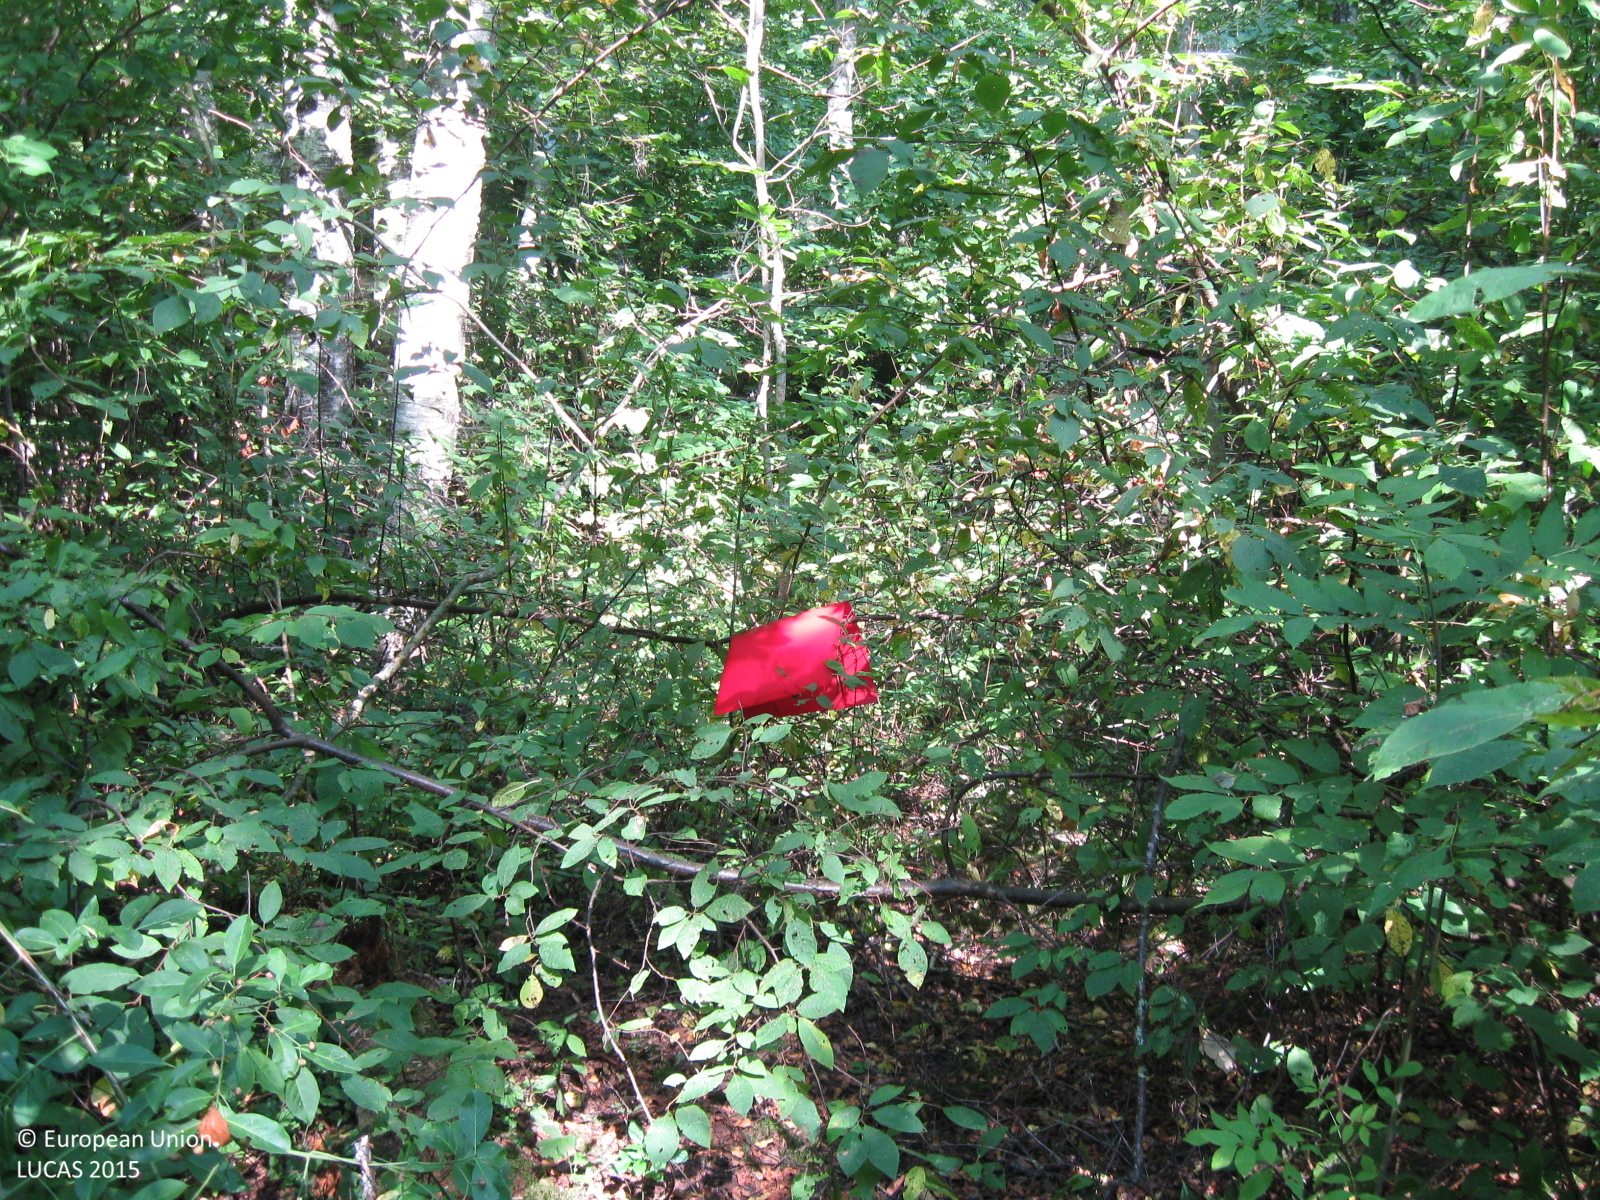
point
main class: Woodland
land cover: Broadleaved woodland
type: non-riverine alder, birch or aspen forest
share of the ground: > 75 %
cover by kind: broadleaved forest trees 95 %, herbaceous plants 5 %
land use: Forestry
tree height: > 5 m
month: August
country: LT
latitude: 55.4929
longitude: 22.9366
